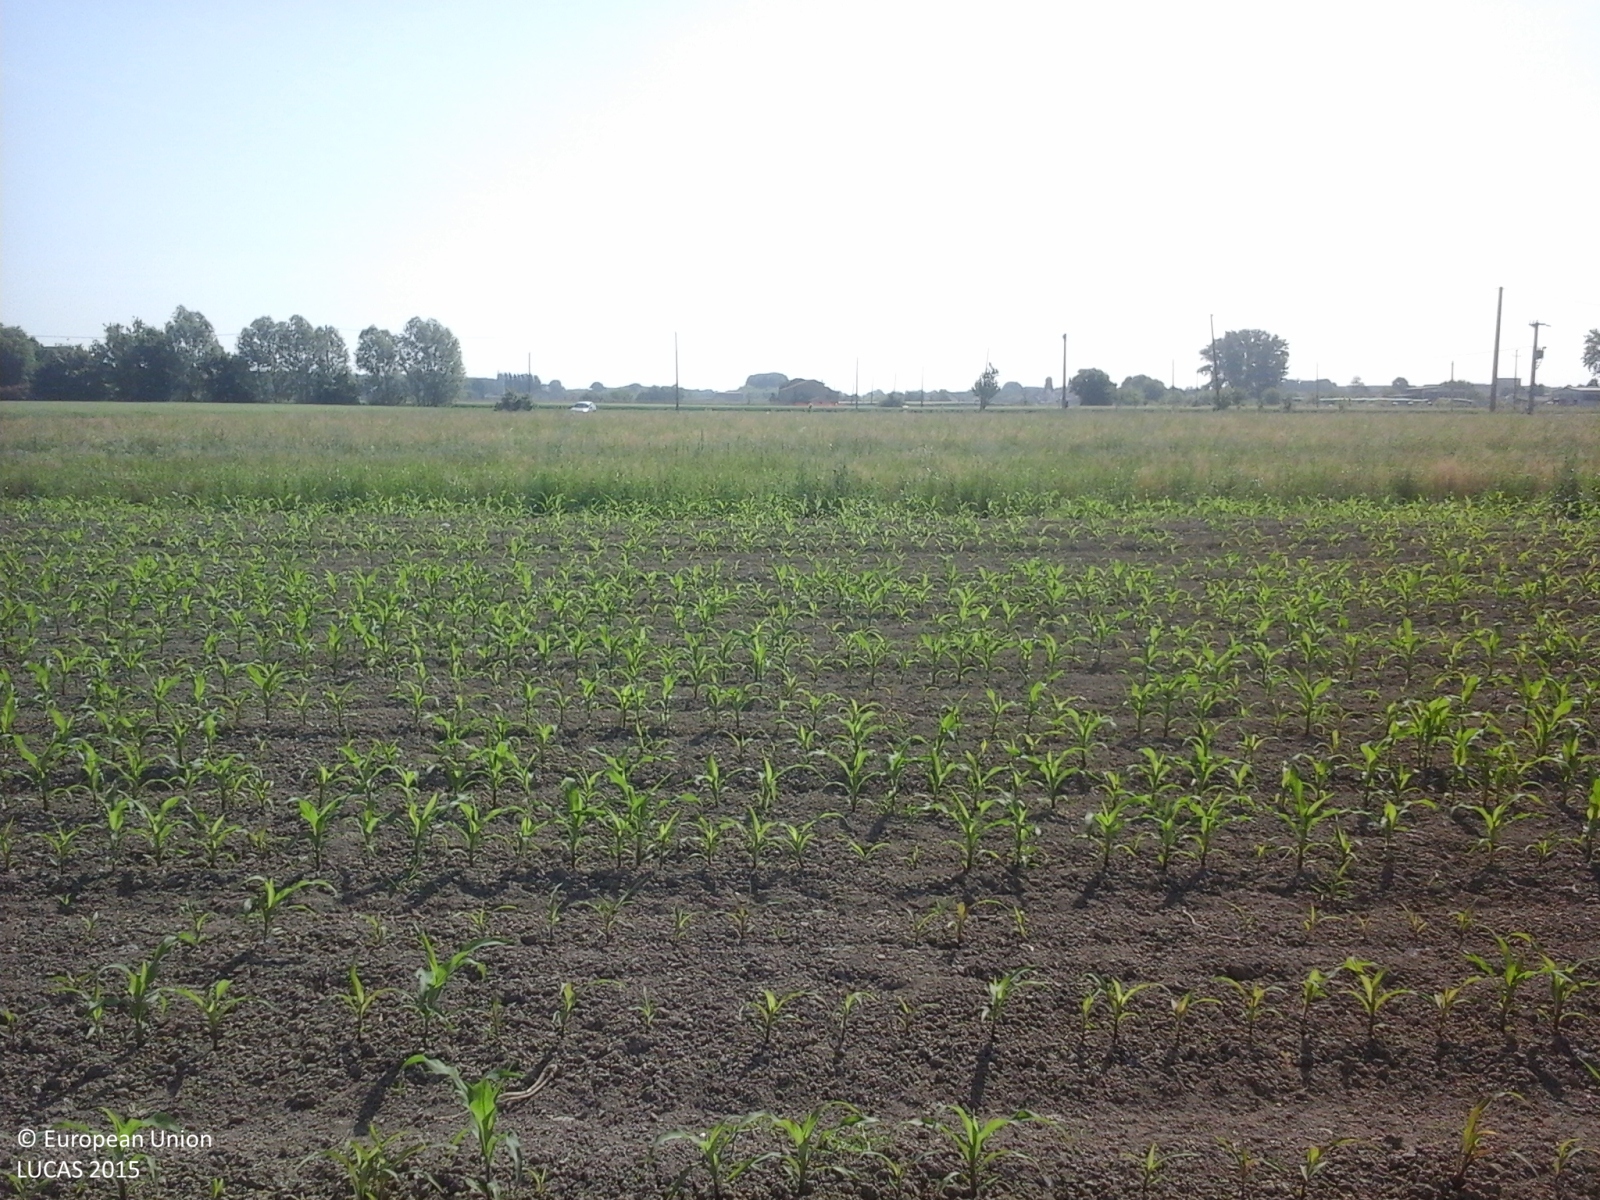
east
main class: Cropland
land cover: Maize
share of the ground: 10 - 25 %
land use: Agriculture (excluding fallow land and kitchen gardens)
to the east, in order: Maize; Grassland without tree/shrub cover; Ditches and canals; Temporary grasslands; Lucerne; Grass margins; Electric lines; Ditches and canals; Grass margins; Paved roads, cycling and walking lanes; Grass margins; Electric lines; Ditches and canals; Grass margins; Lucerne; Common wheat
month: May
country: IT
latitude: 45.0493
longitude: 10.9758
